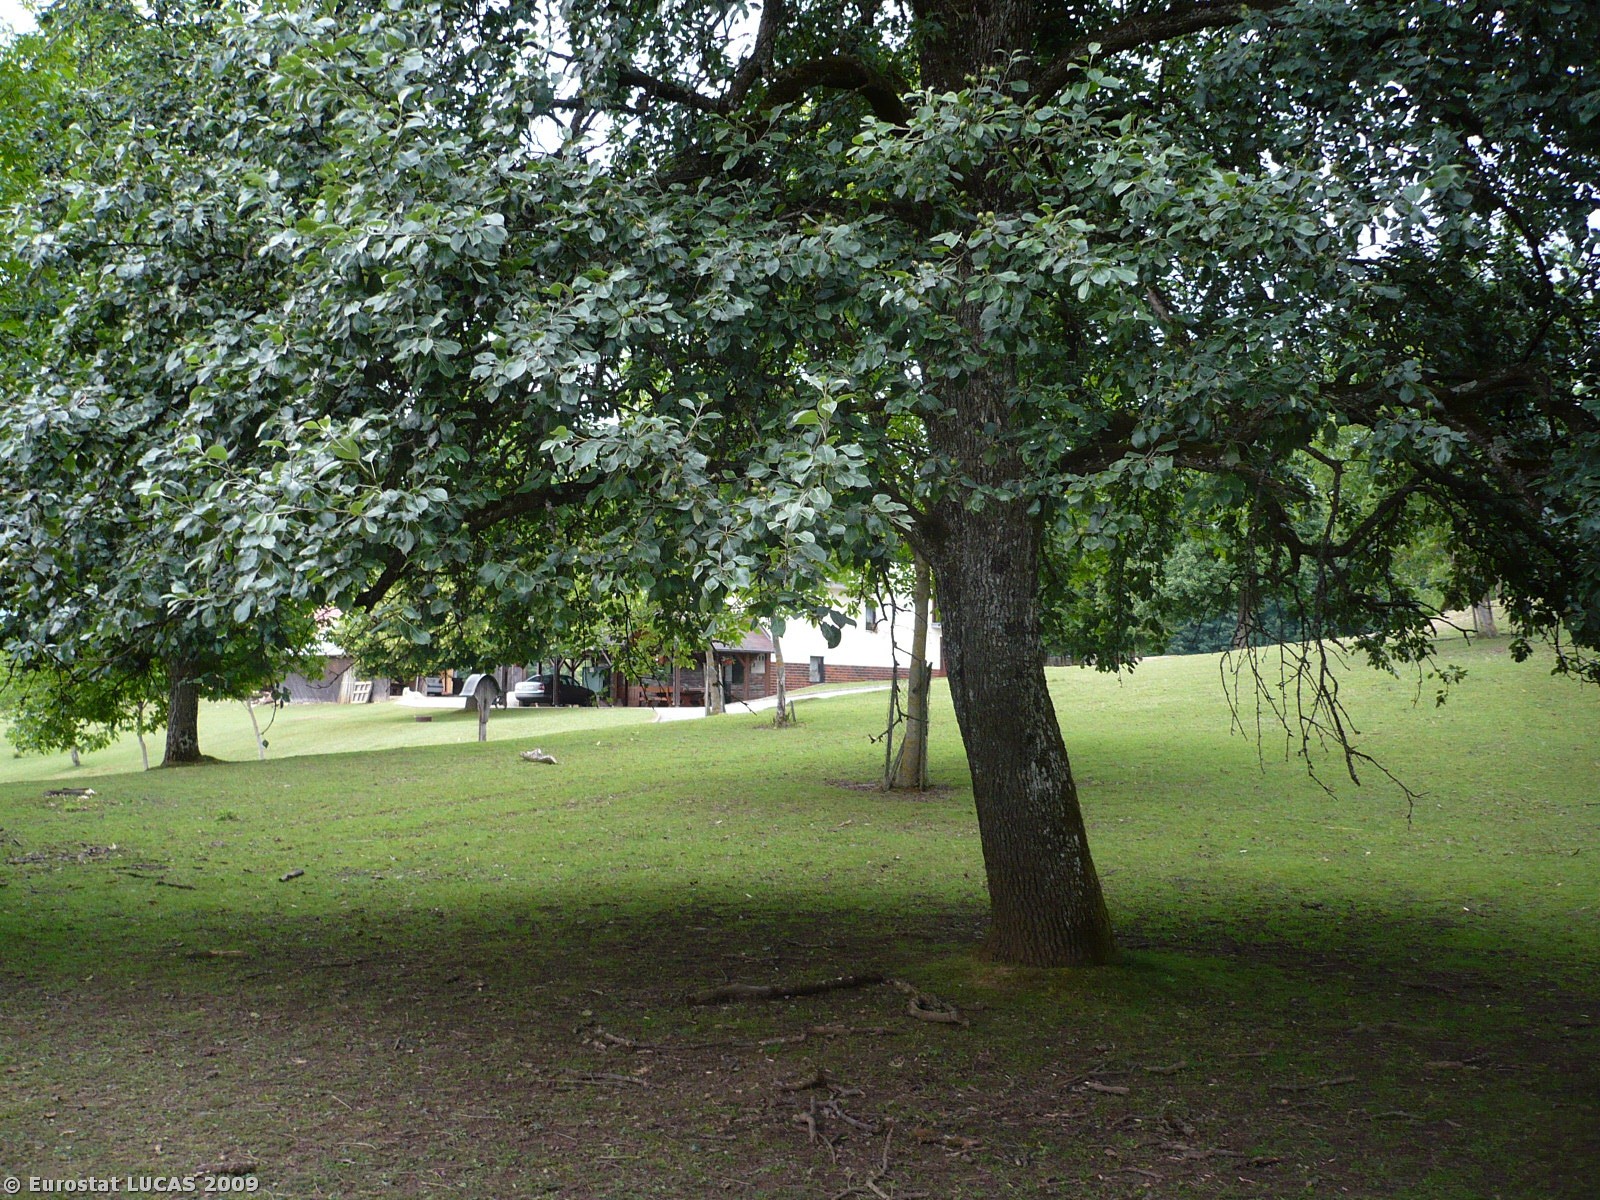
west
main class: Cropland
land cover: Nuts trees
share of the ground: 25 - 50 %
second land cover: Grassland with sparse tree/shrub cover
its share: 50 - 75 %
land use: Agriculture (excluding fallow land and kitchen gardens)
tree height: > 5 m
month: June
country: SI
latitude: 45.6591
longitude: 15.3224
